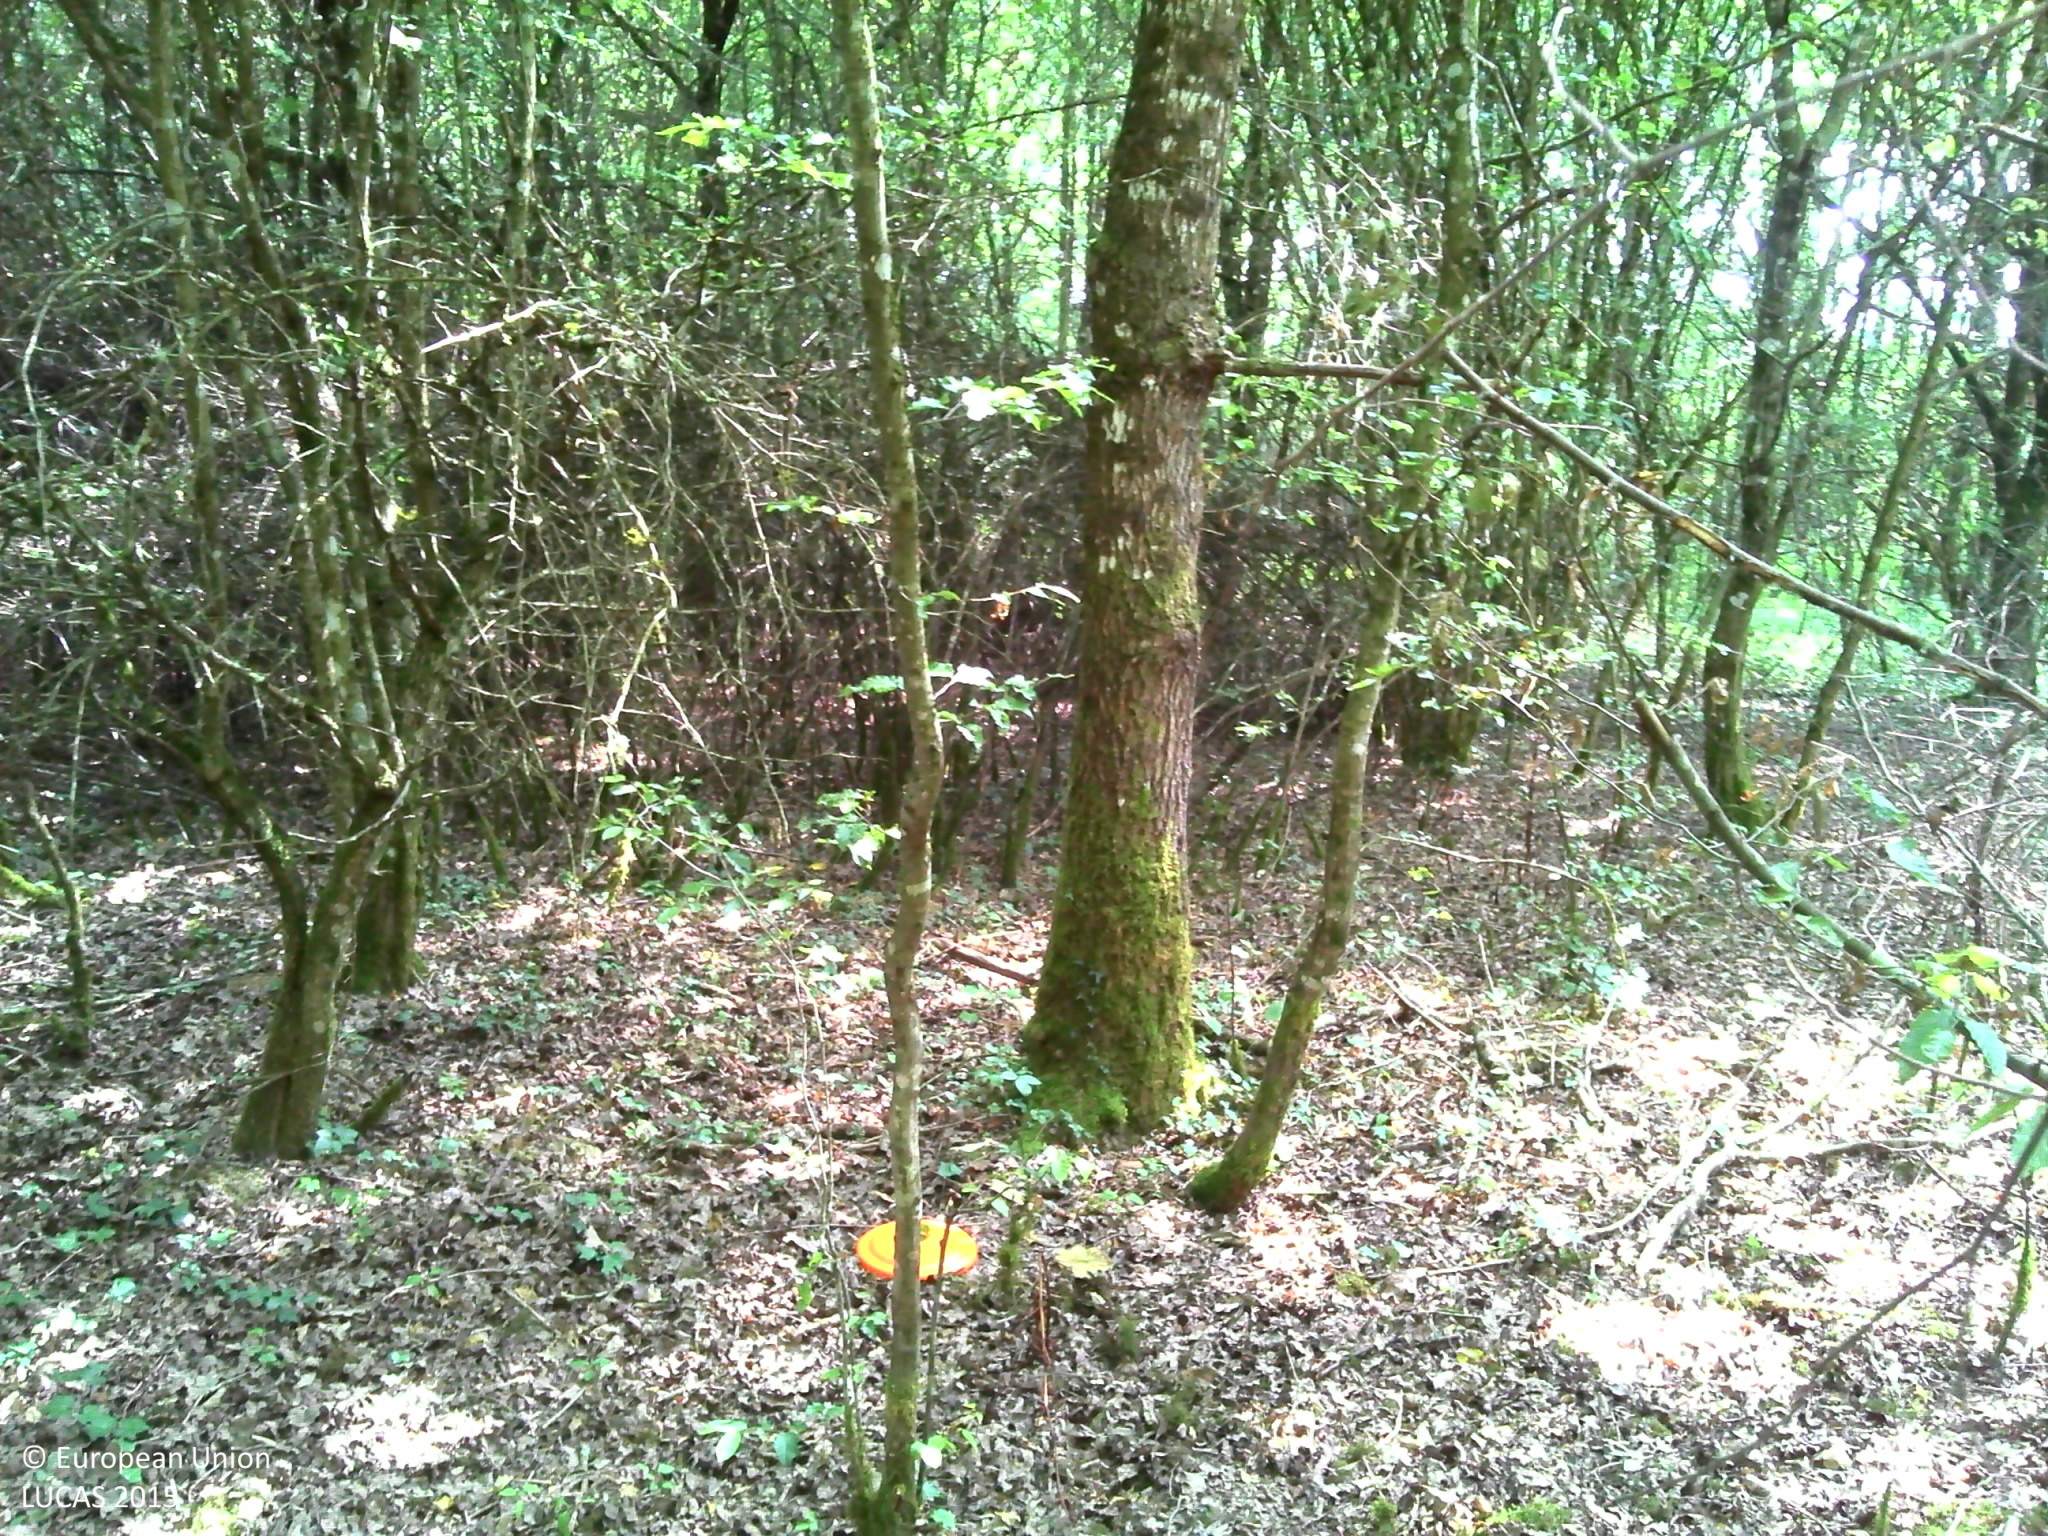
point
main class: Woodland
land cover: Broadleaved woodland
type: mesophytic deciduous forest
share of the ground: > 75 %
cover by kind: broadleaved forest trees 90 %, herbaceous plants 5 %, lichens and mosses 5 %
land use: Forestry
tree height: > 5 m
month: August
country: FR
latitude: 47.7397
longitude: 3.1530
